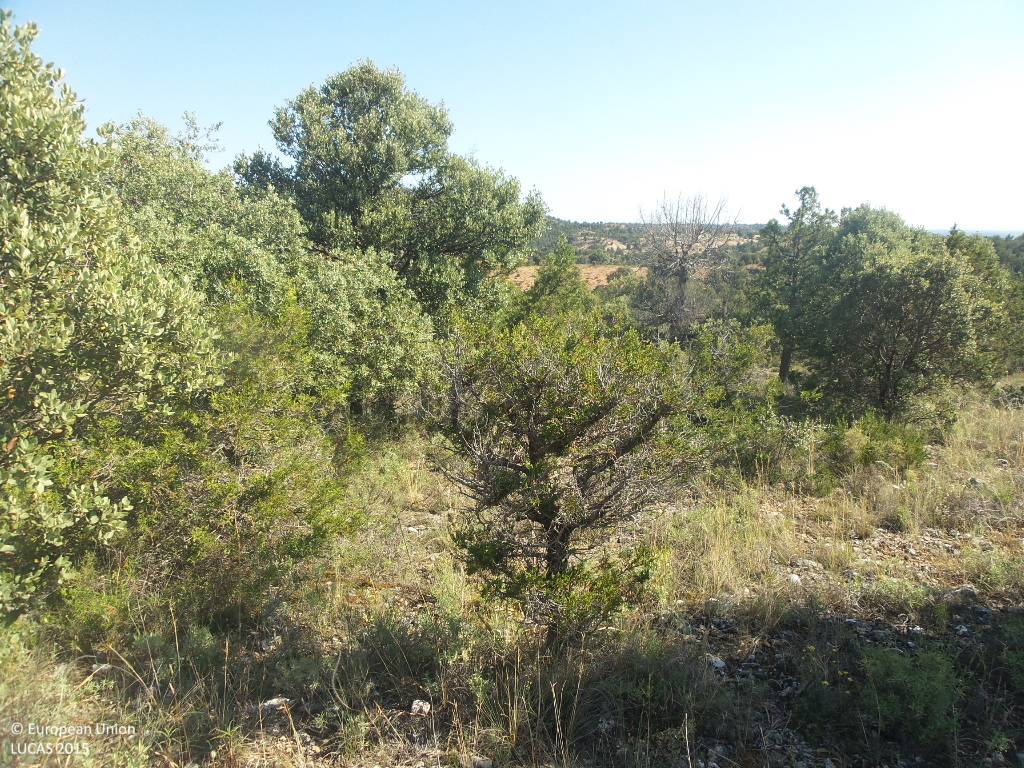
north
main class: Woodland
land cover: Other mixed woodland
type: coniferous forest of the mediterranean region
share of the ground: 50 - 75 %
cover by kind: coniferous forest trees 25 %, broadleaved forest trees 25 %, shrubs 25 %, unconsolidated bare surface 20 %, herbaceous plants 5 %
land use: Semi-natural and natural areas not in use
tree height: < 5 m
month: June
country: ES
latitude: 41.4494
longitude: -2.9804
